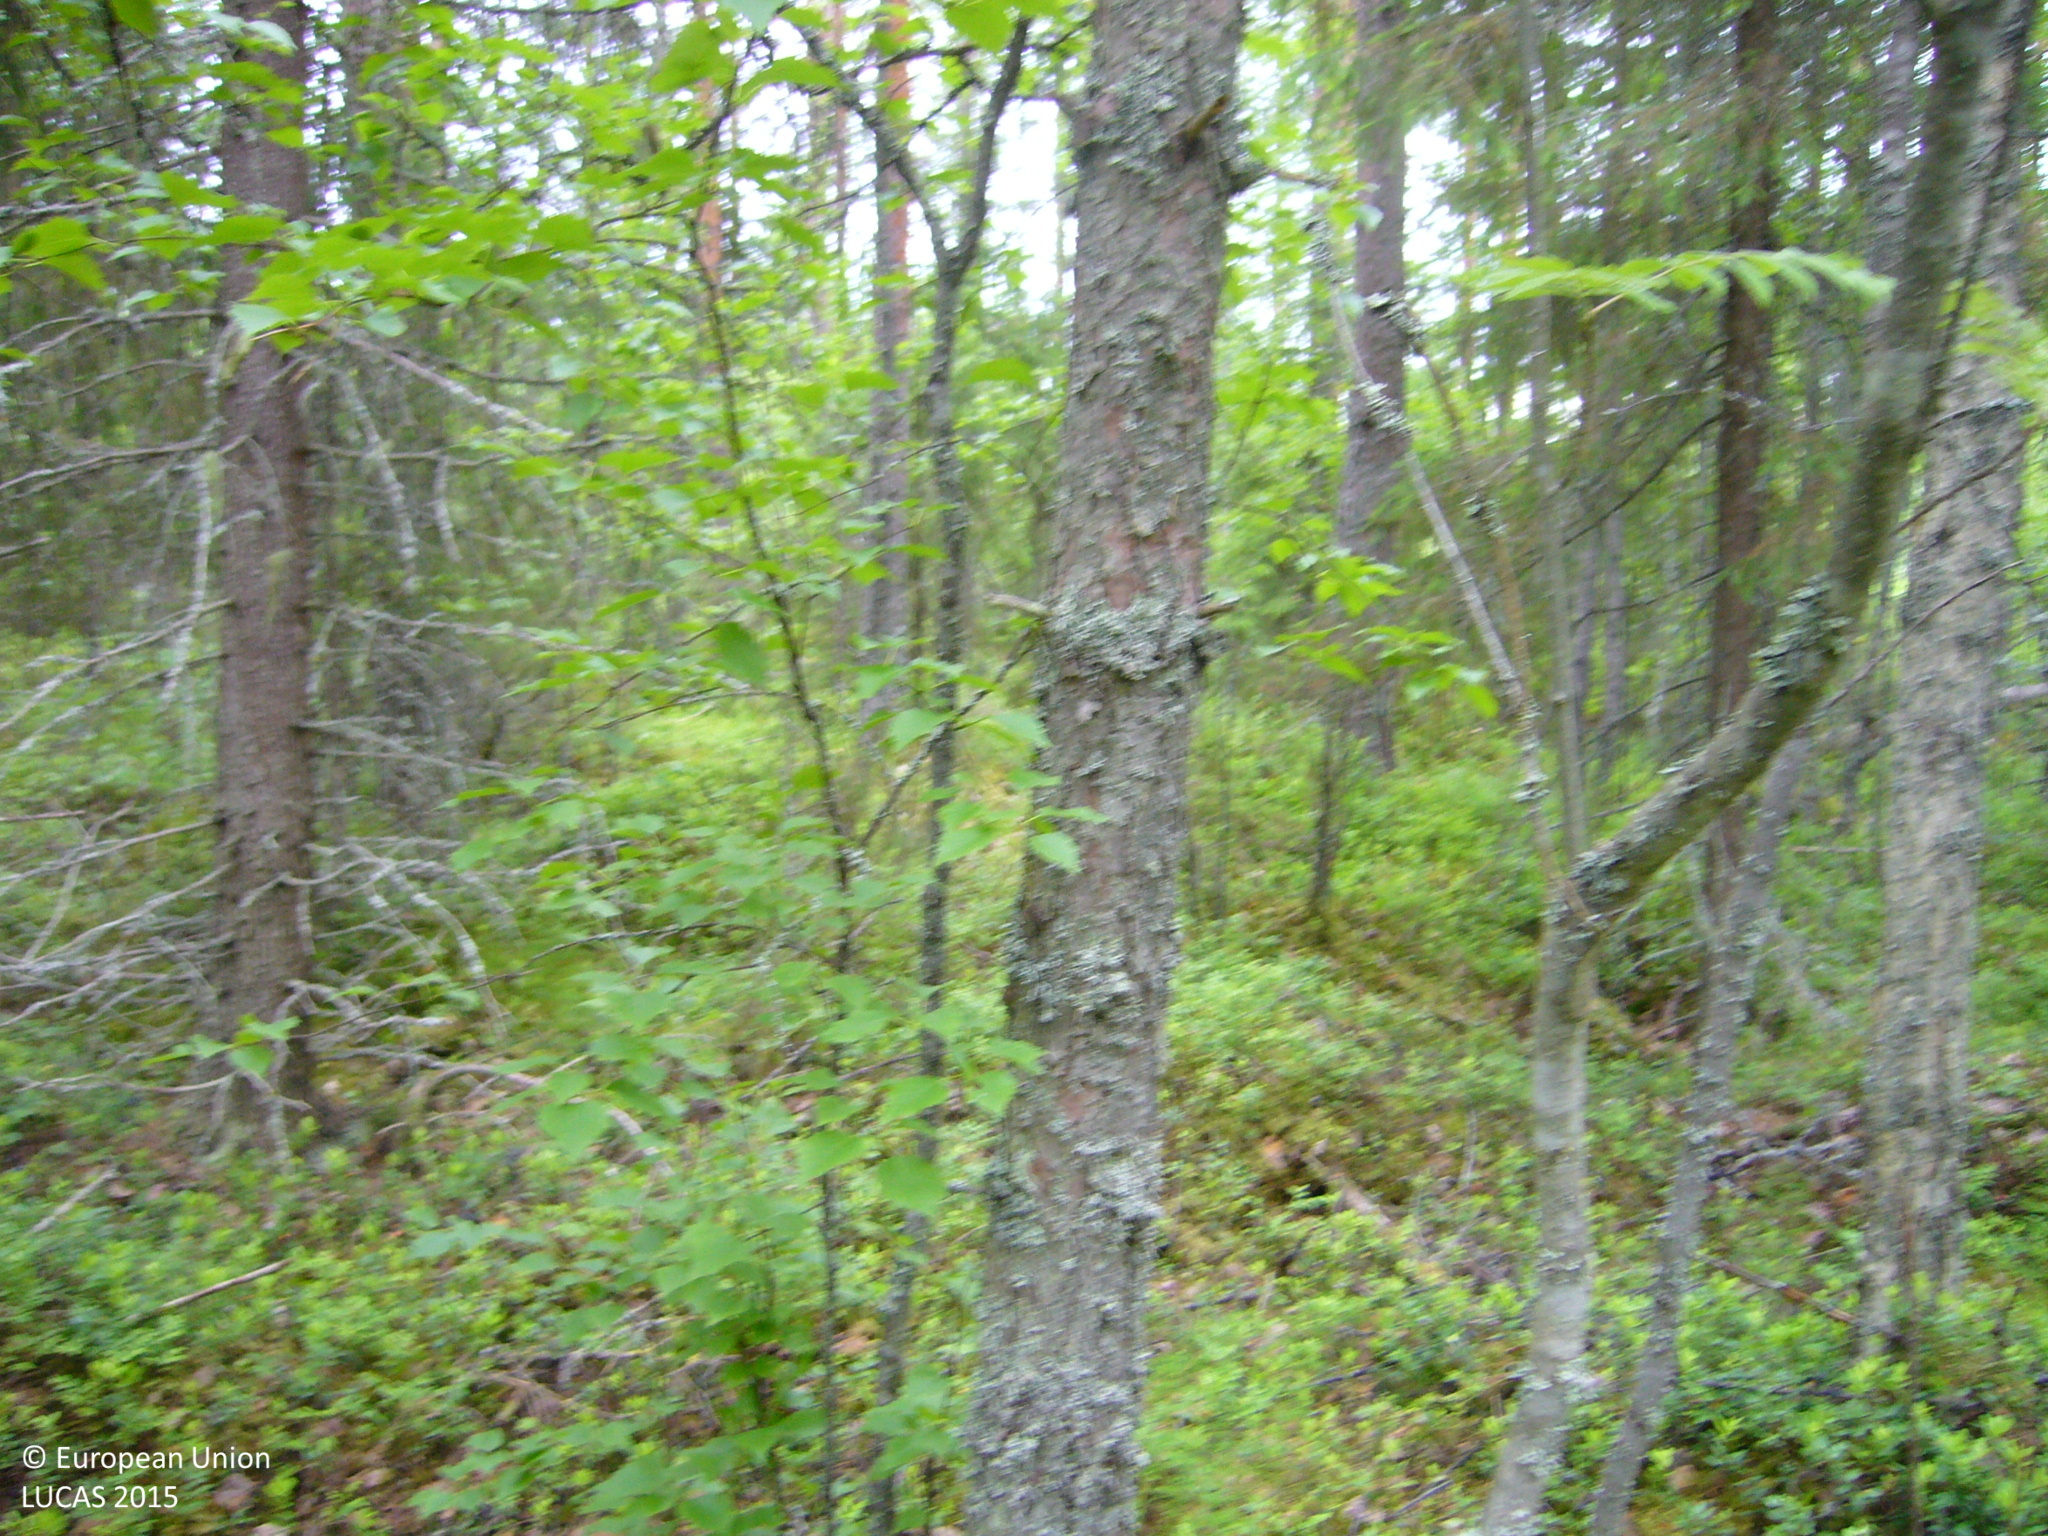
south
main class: Woodland
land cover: Other mixed woodland
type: boreal forest
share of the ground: > 75 %
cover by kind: coniferous forest trees 45 %, broadleaved forest trees 35 %, shrubs 20 %
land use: Forestry
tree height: > 5 m
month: July
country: FI
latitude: 63.3917
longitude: 26.1894
